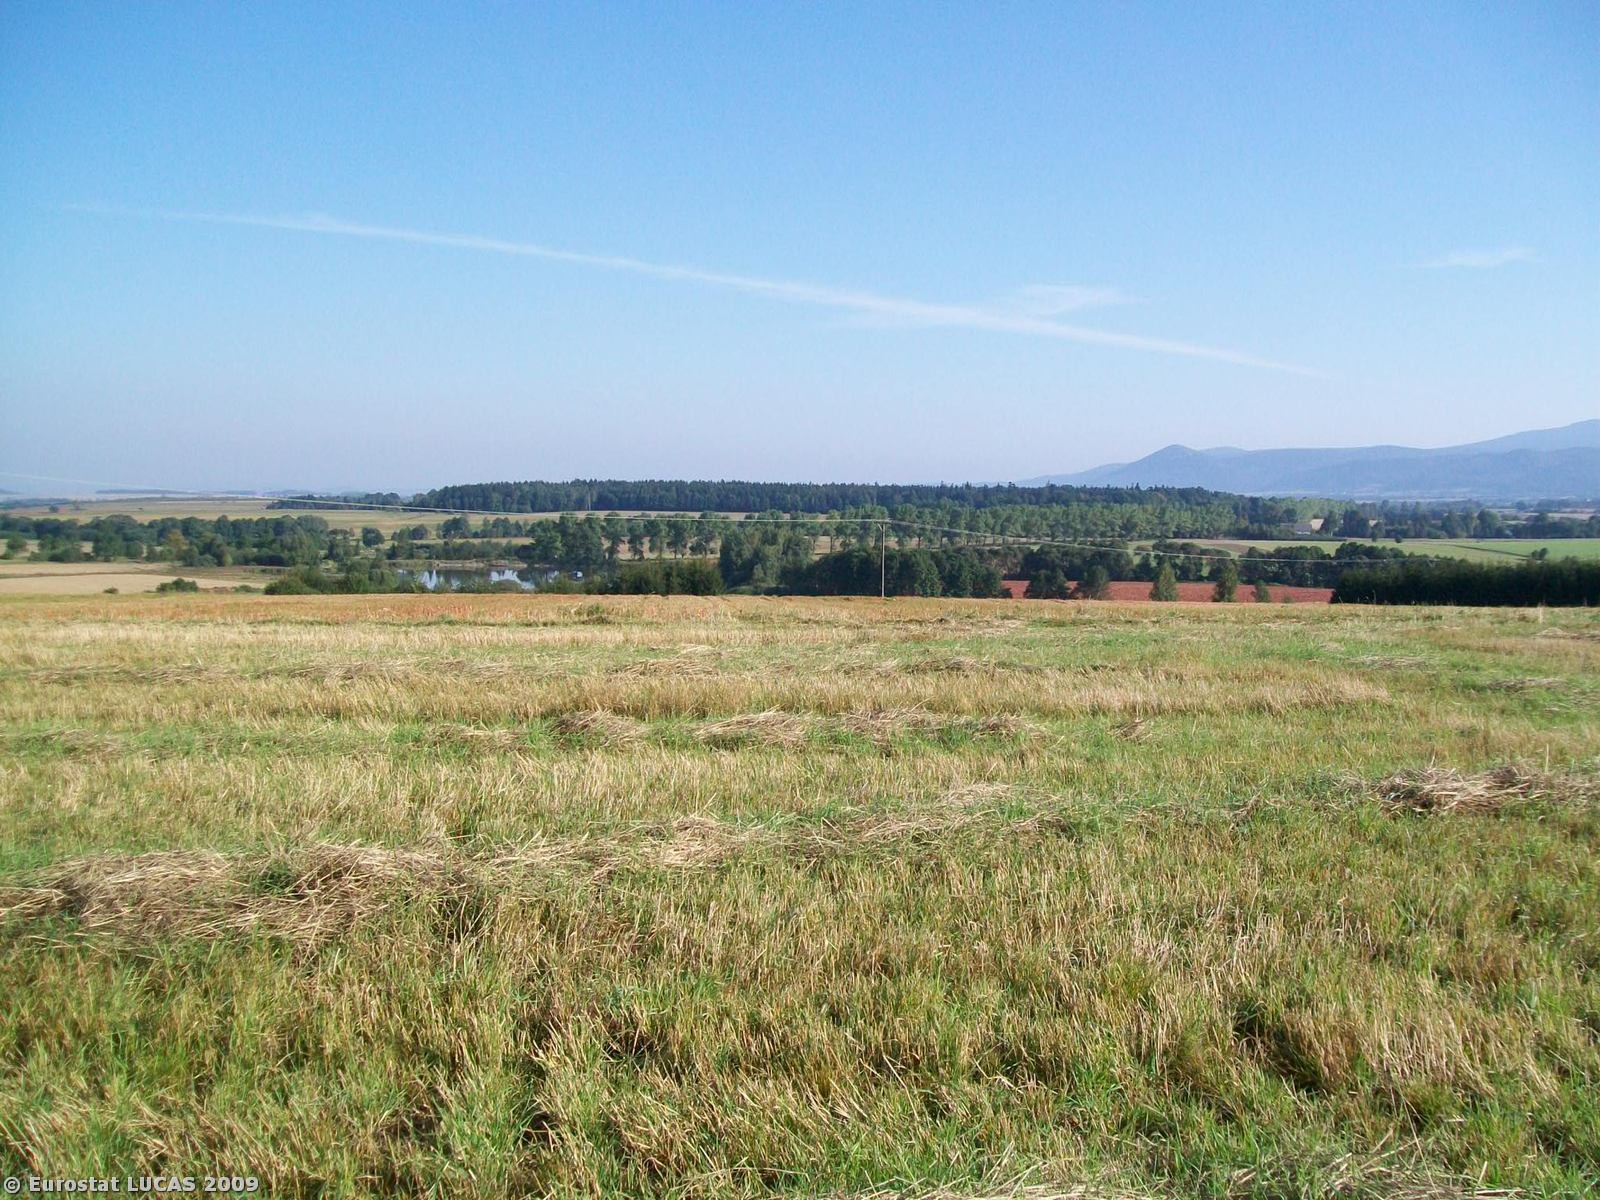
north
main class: Grassland
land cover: Grassland without tree/shrub cover
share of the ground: > 75 %
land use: Agriculture (excluding fallow land and kitchen gardens)
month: September
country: PL
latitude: 50.1505
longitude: 16.6840
